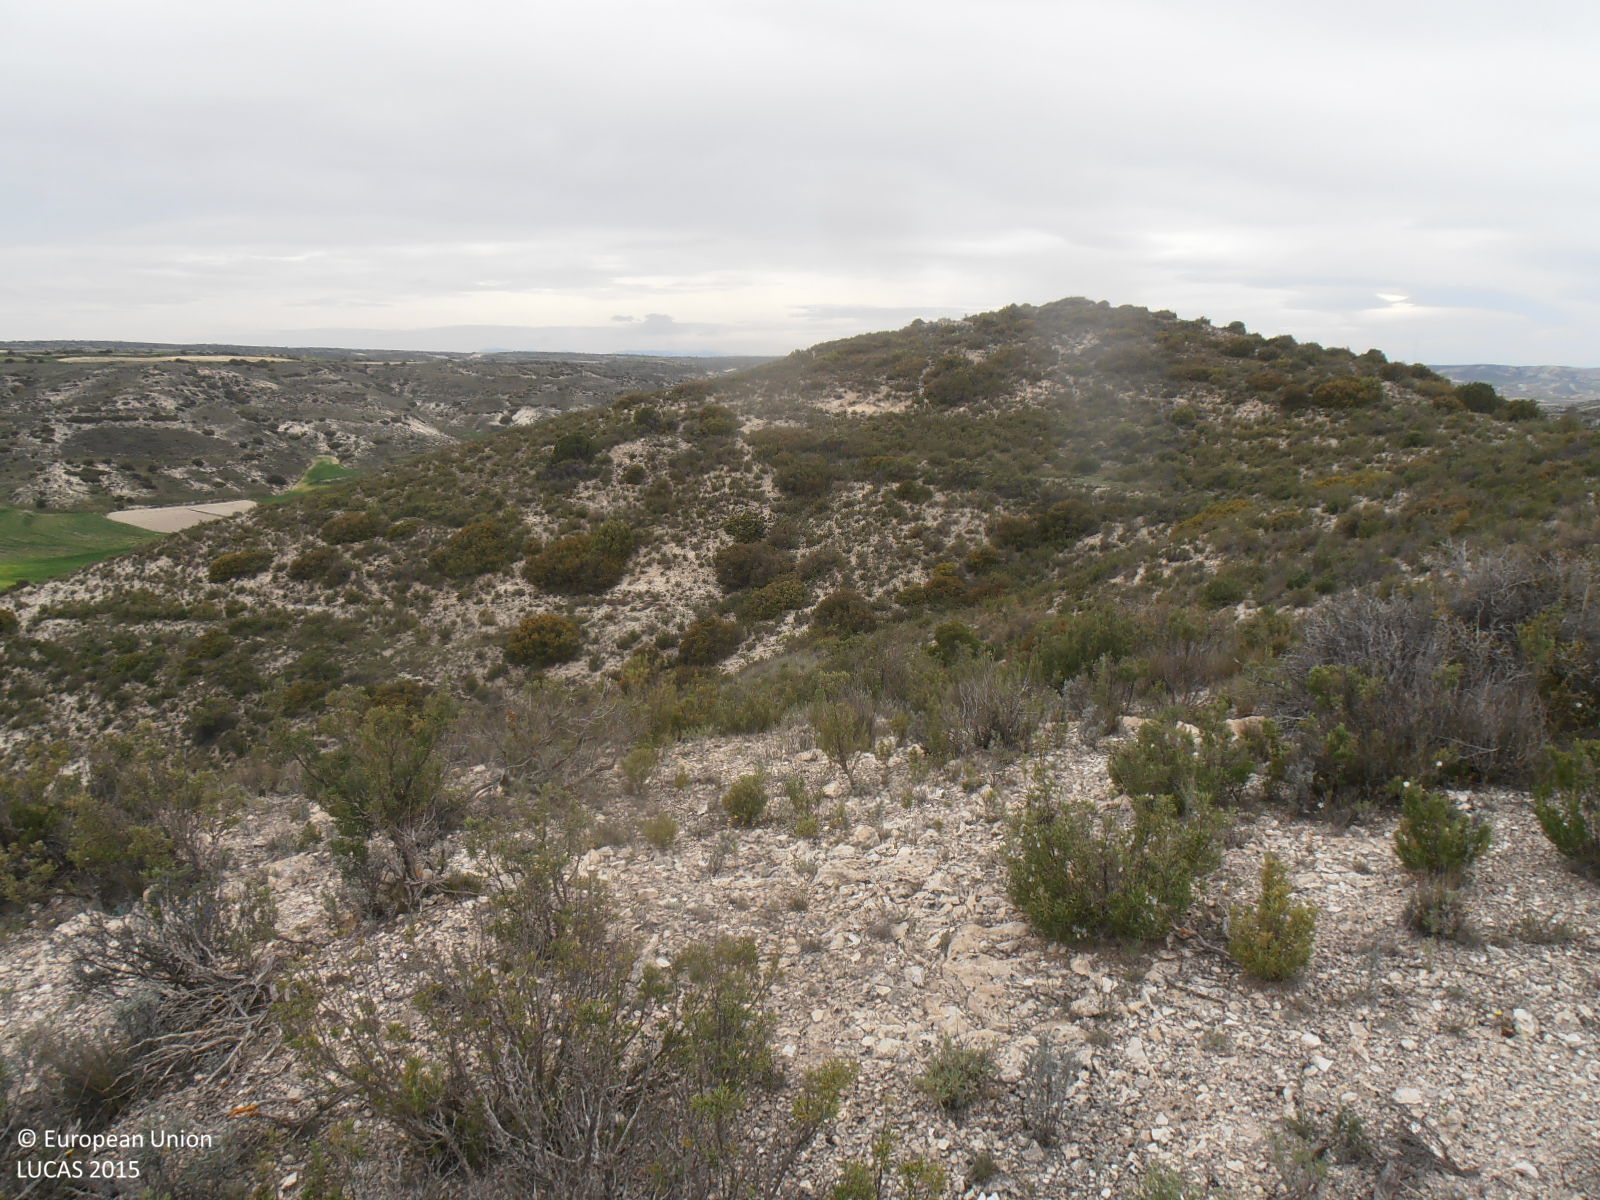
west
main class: Shrubland
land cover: Shrubland without tree cover
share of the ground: > 75 %
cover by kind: shrubs 75 %, consolidated bare surface 25 %
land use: Semi-natural and natural areas not in use
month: May
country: ES
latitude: 41.4217
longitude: -0.9442
